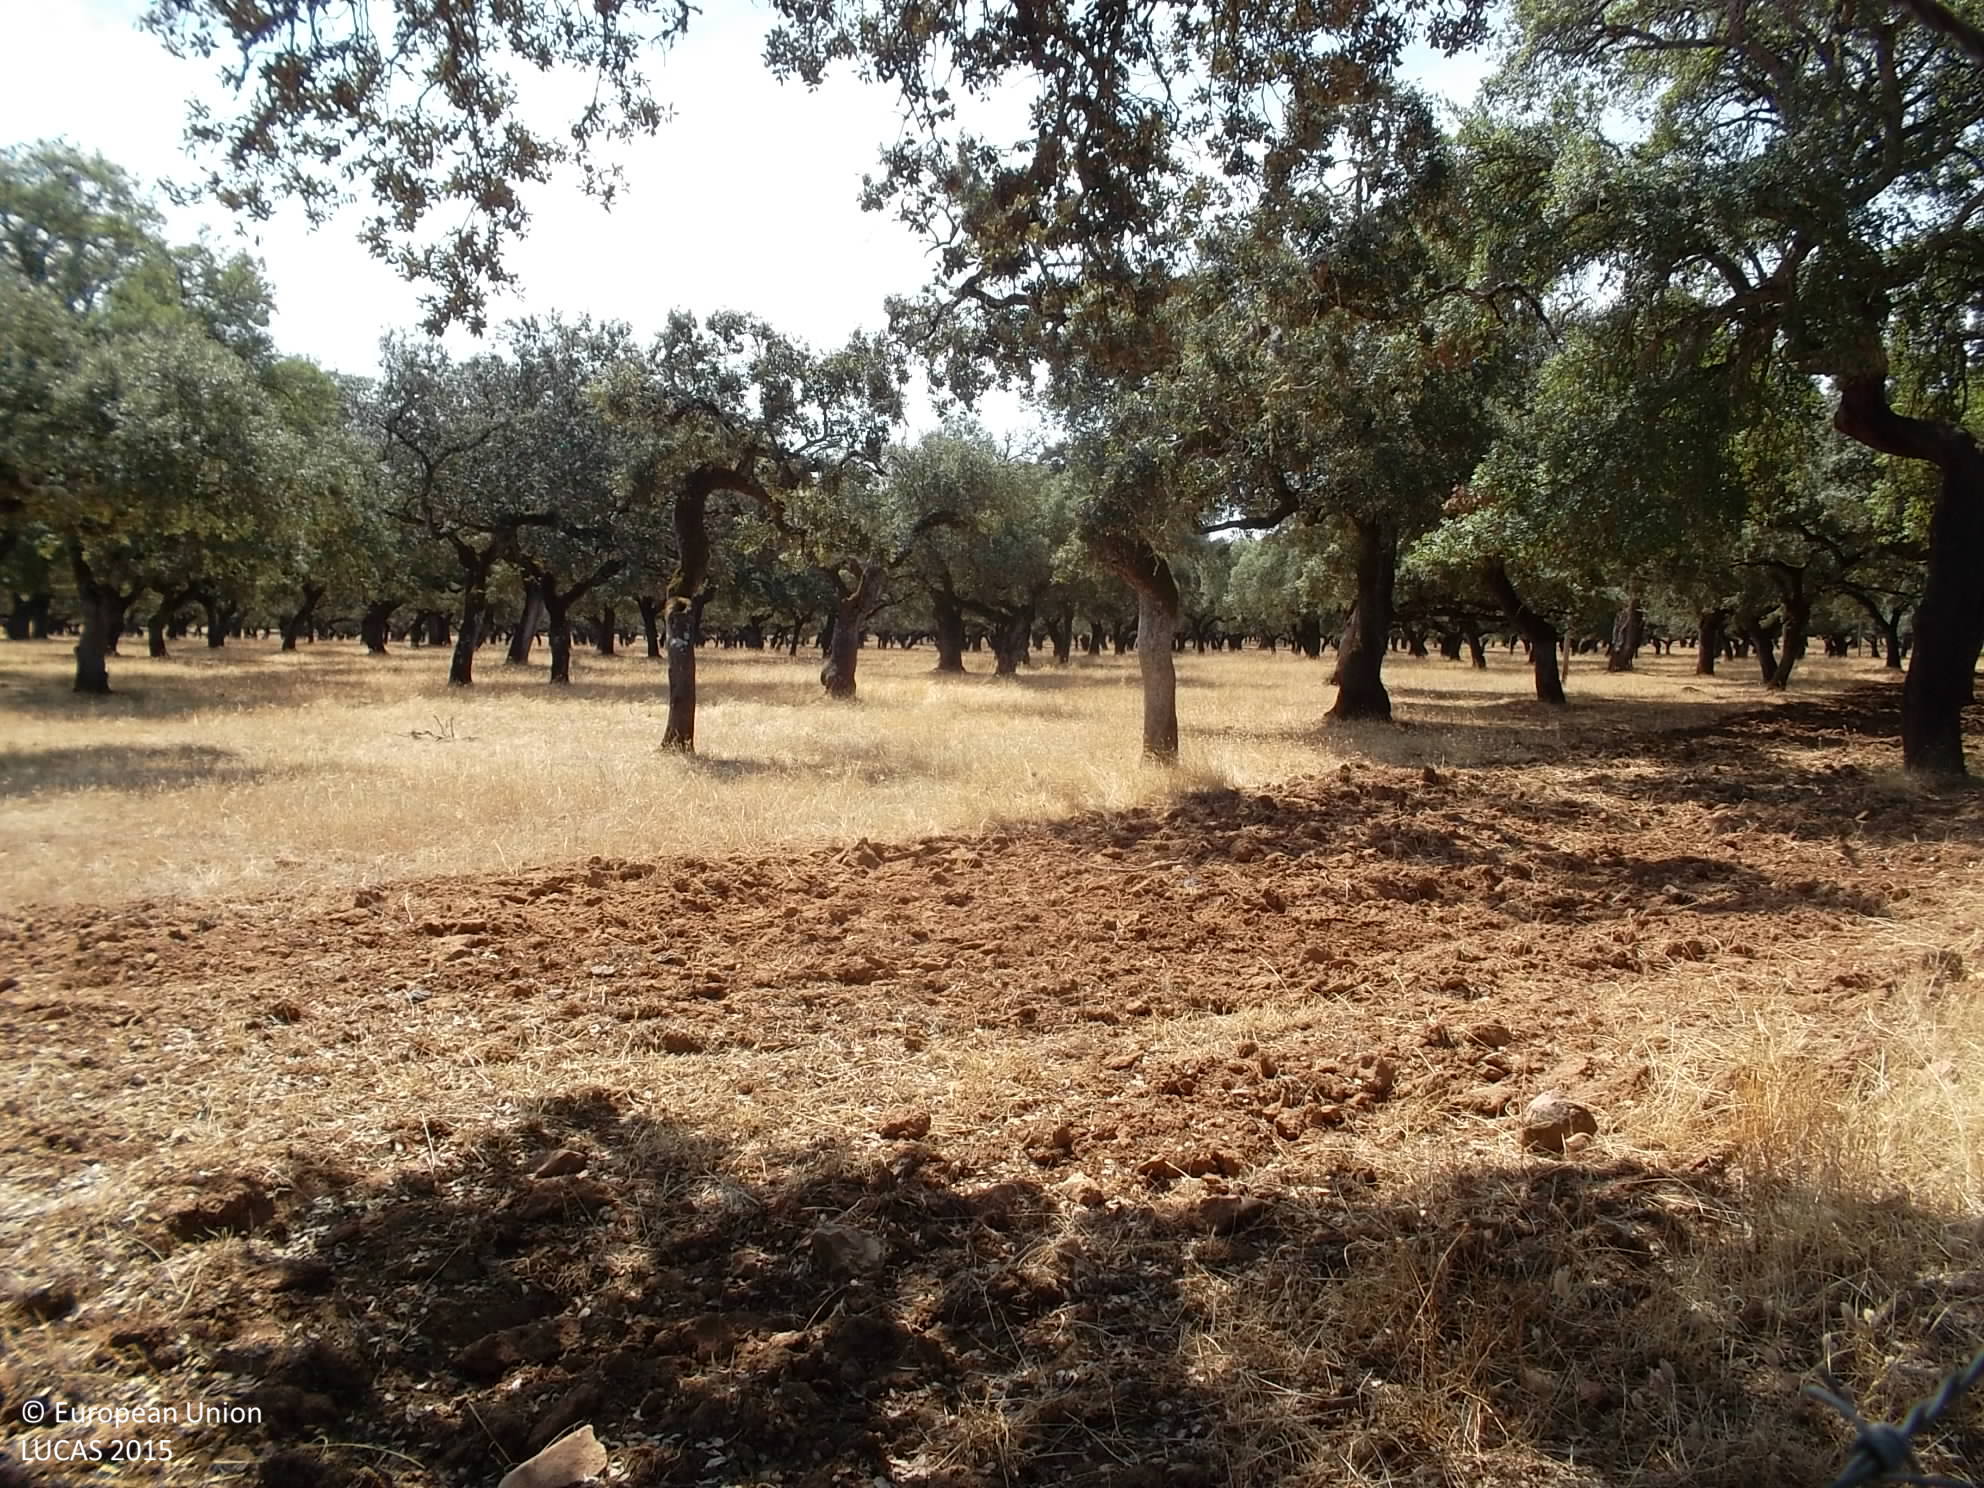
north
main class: Woodland
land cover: Broadleaved woodland
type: broadleaved evergreen forest
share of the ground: 50 - 75 %
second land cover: Grassland without tree/shrub cover
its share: > 75 %
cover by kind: broadleaved forest trees 50 %, herbaceous plants 50 %
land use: Forestry
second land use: Agriculture (excluding fallow land and kitchen gardens)
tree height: > 5 m
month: August
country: ES
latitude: 38.2074
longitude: -6.6444
